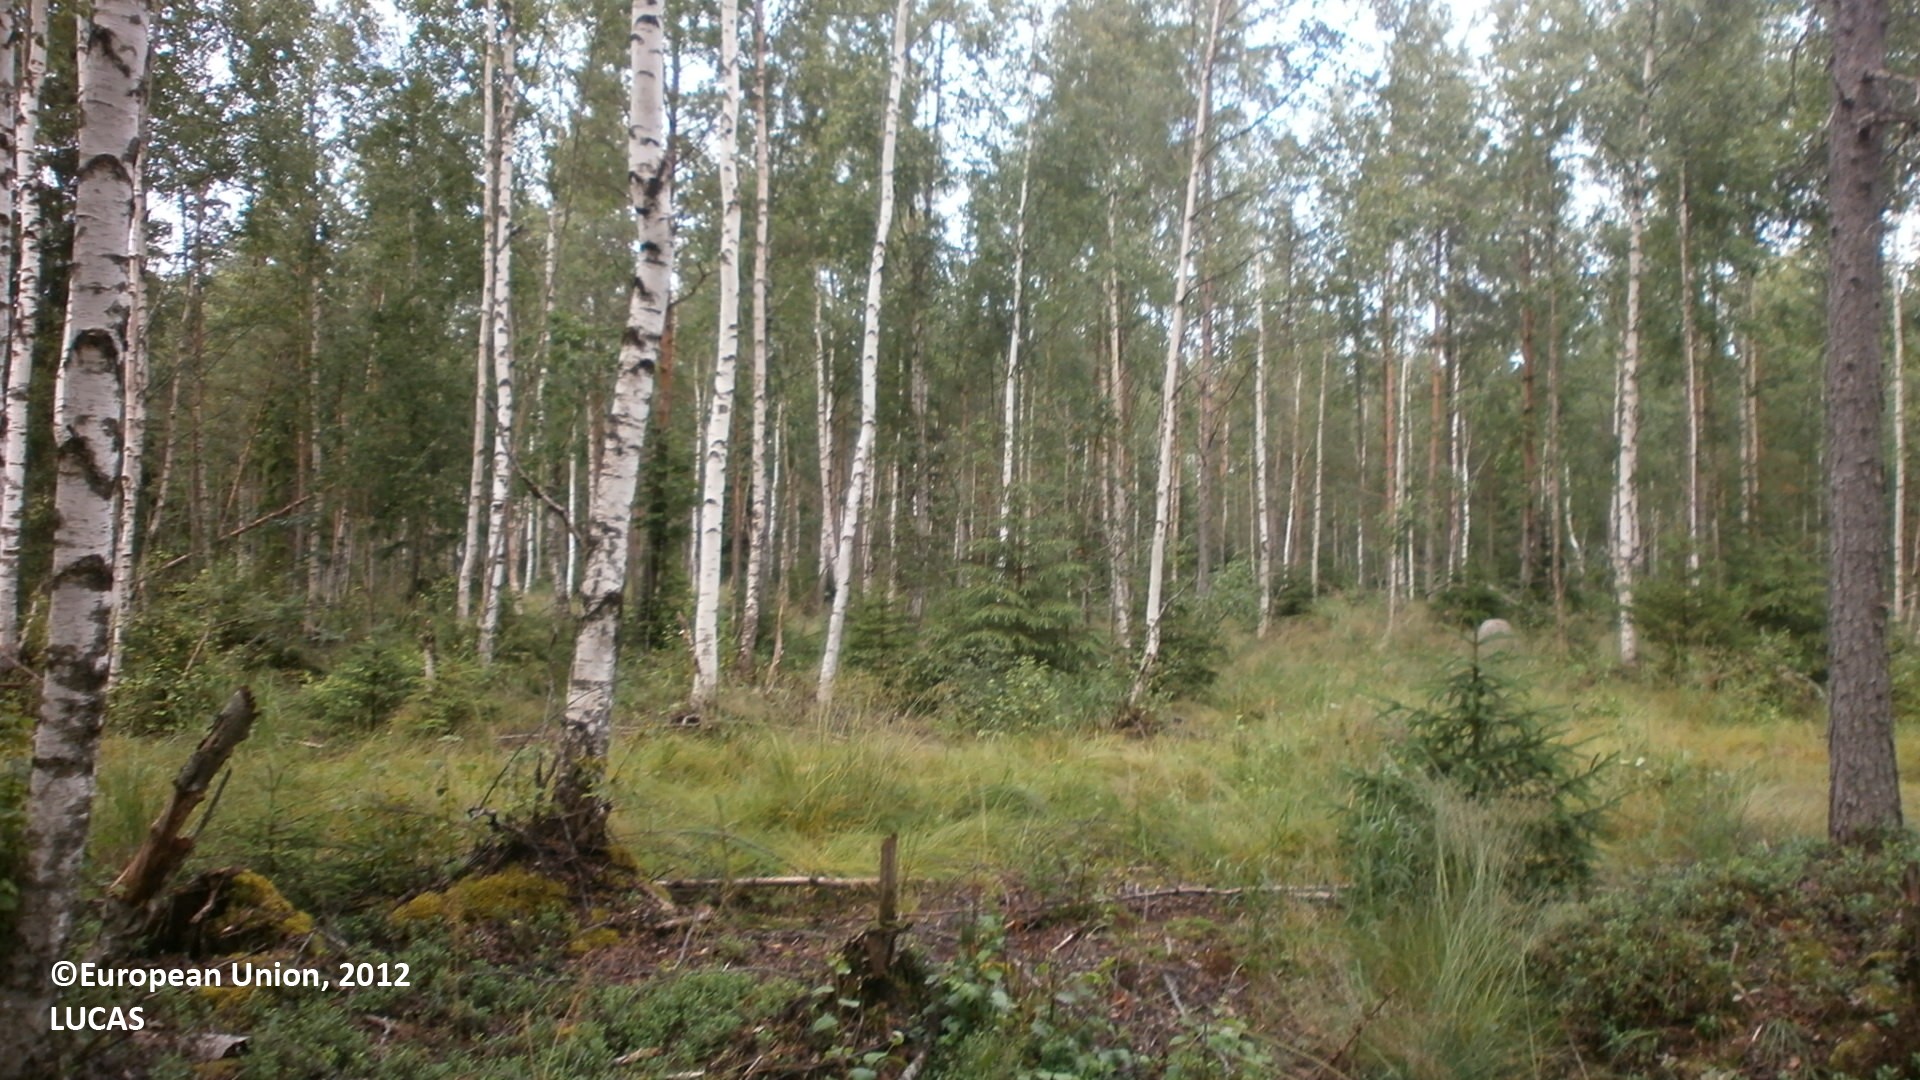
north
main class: Woodland
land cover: Pine dominated mixed woodland
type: boreal forest
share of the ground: 50 - 75 %
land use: Forestry
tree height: > 5 m
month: July
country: FI
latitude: 64.1086
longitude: 23.7505
